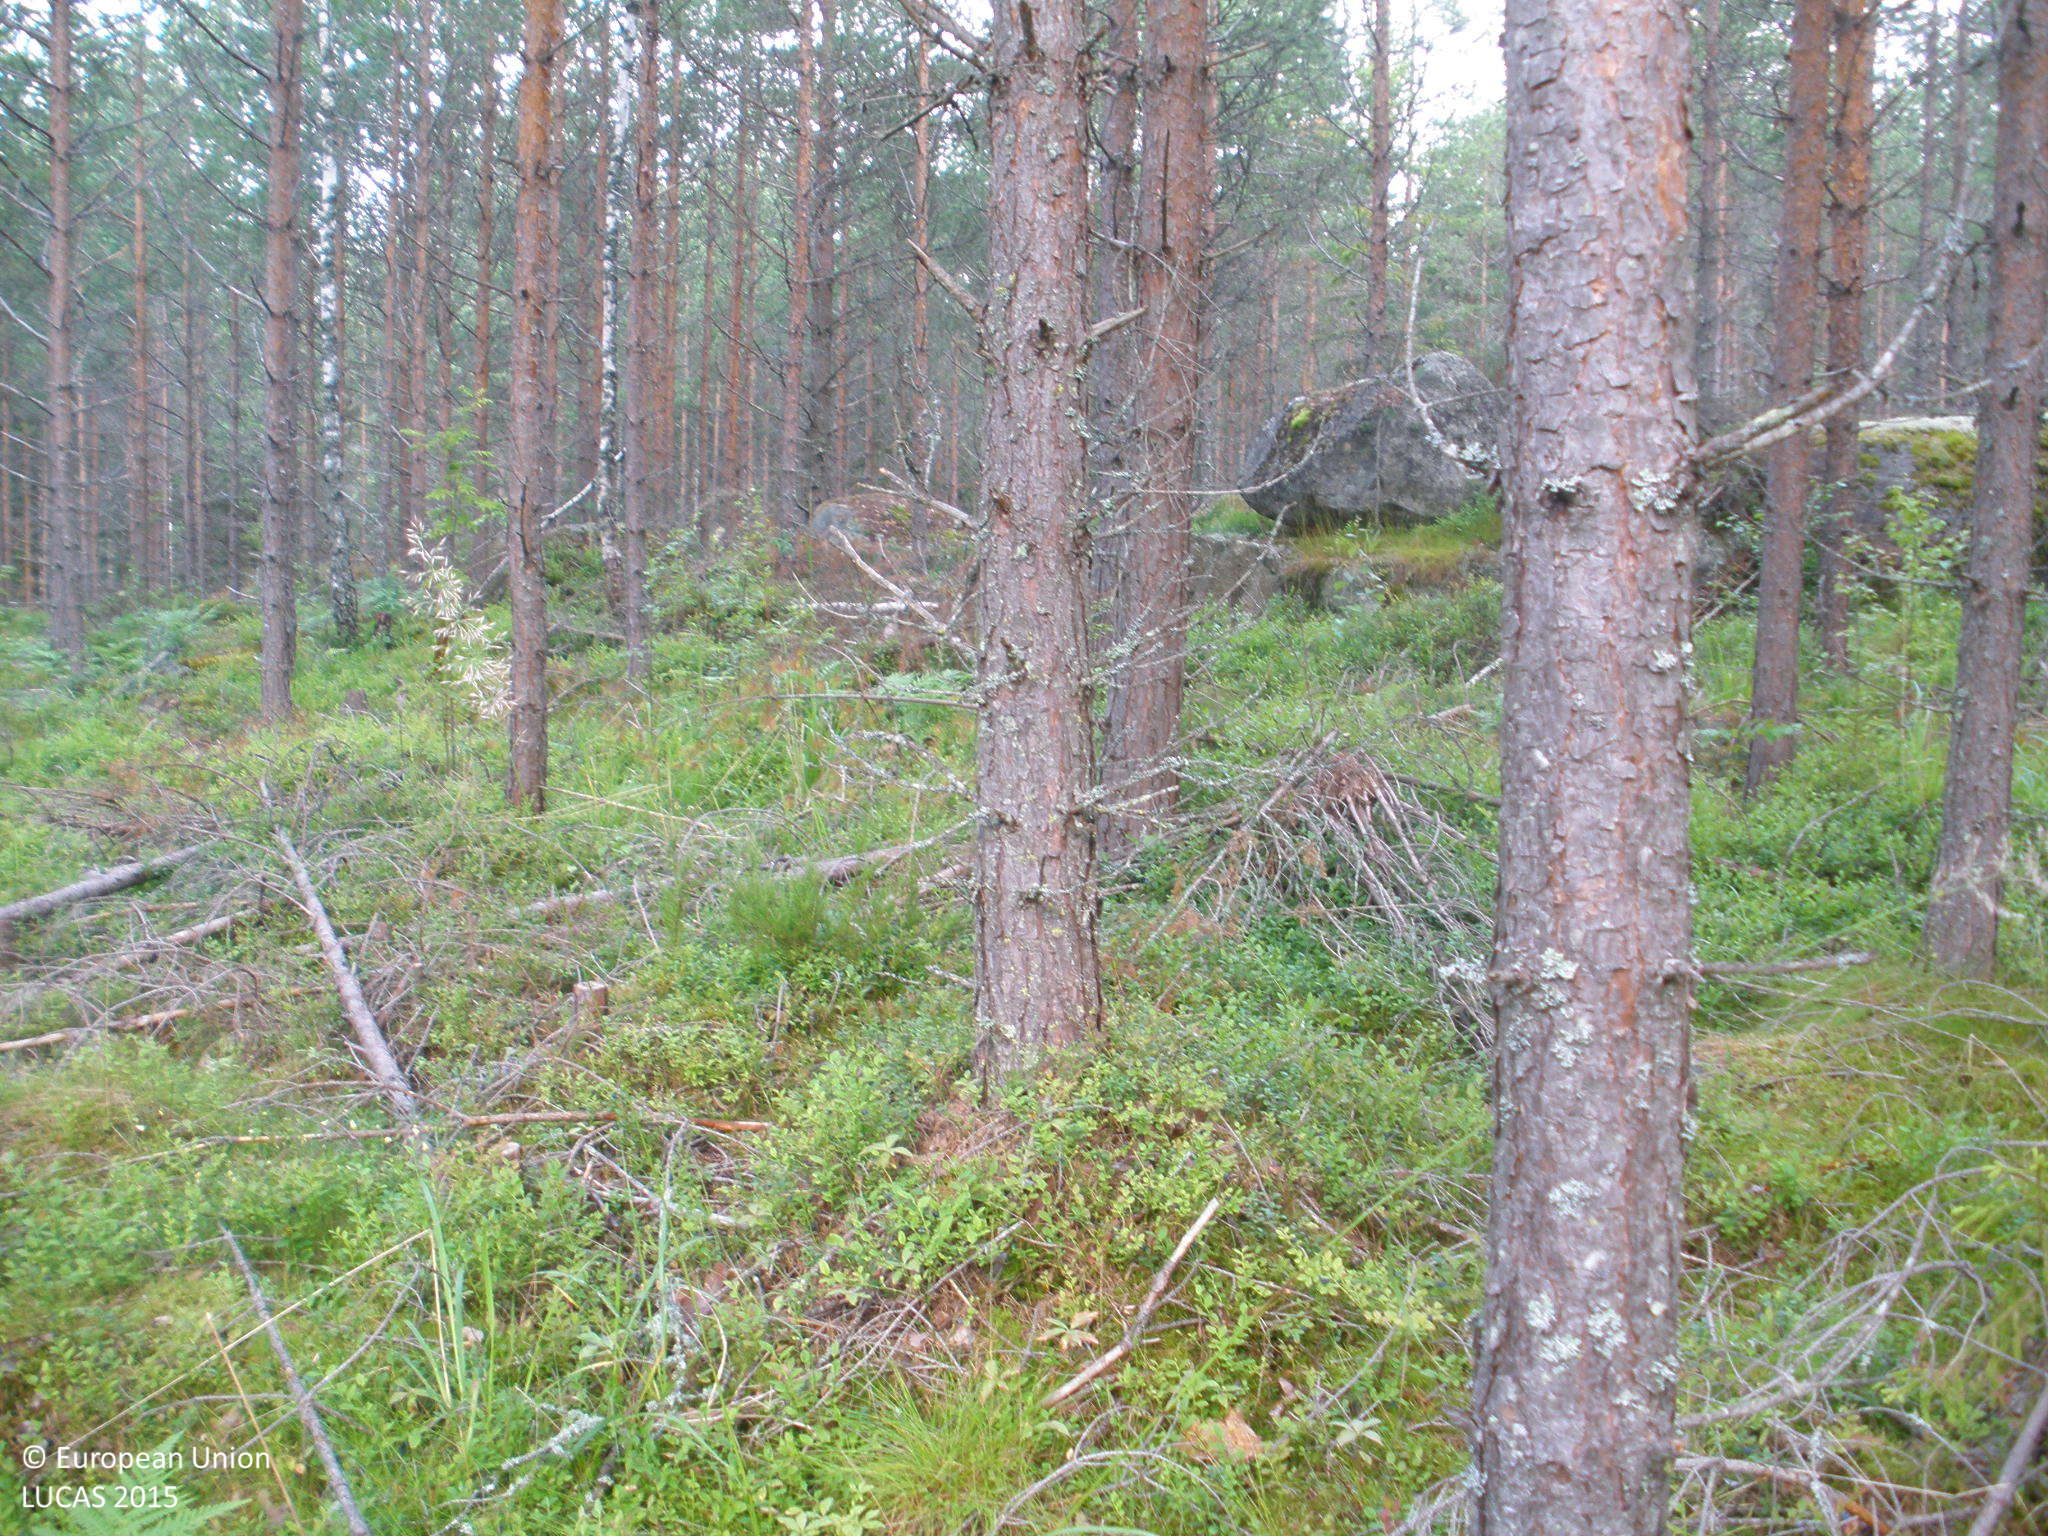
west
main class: Woodland
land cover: Pine dominated coniferous woodland
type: boreal forest
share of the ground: > 75 %
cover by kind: coniferous forest trees 70 %, herbaceous plants 15 %, lichens and mosses 10 %, broadleaved forest trees 5 %
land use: Forestry
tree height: > 5 m
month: July
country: FI
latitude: 60.9749
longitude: 25.1381
